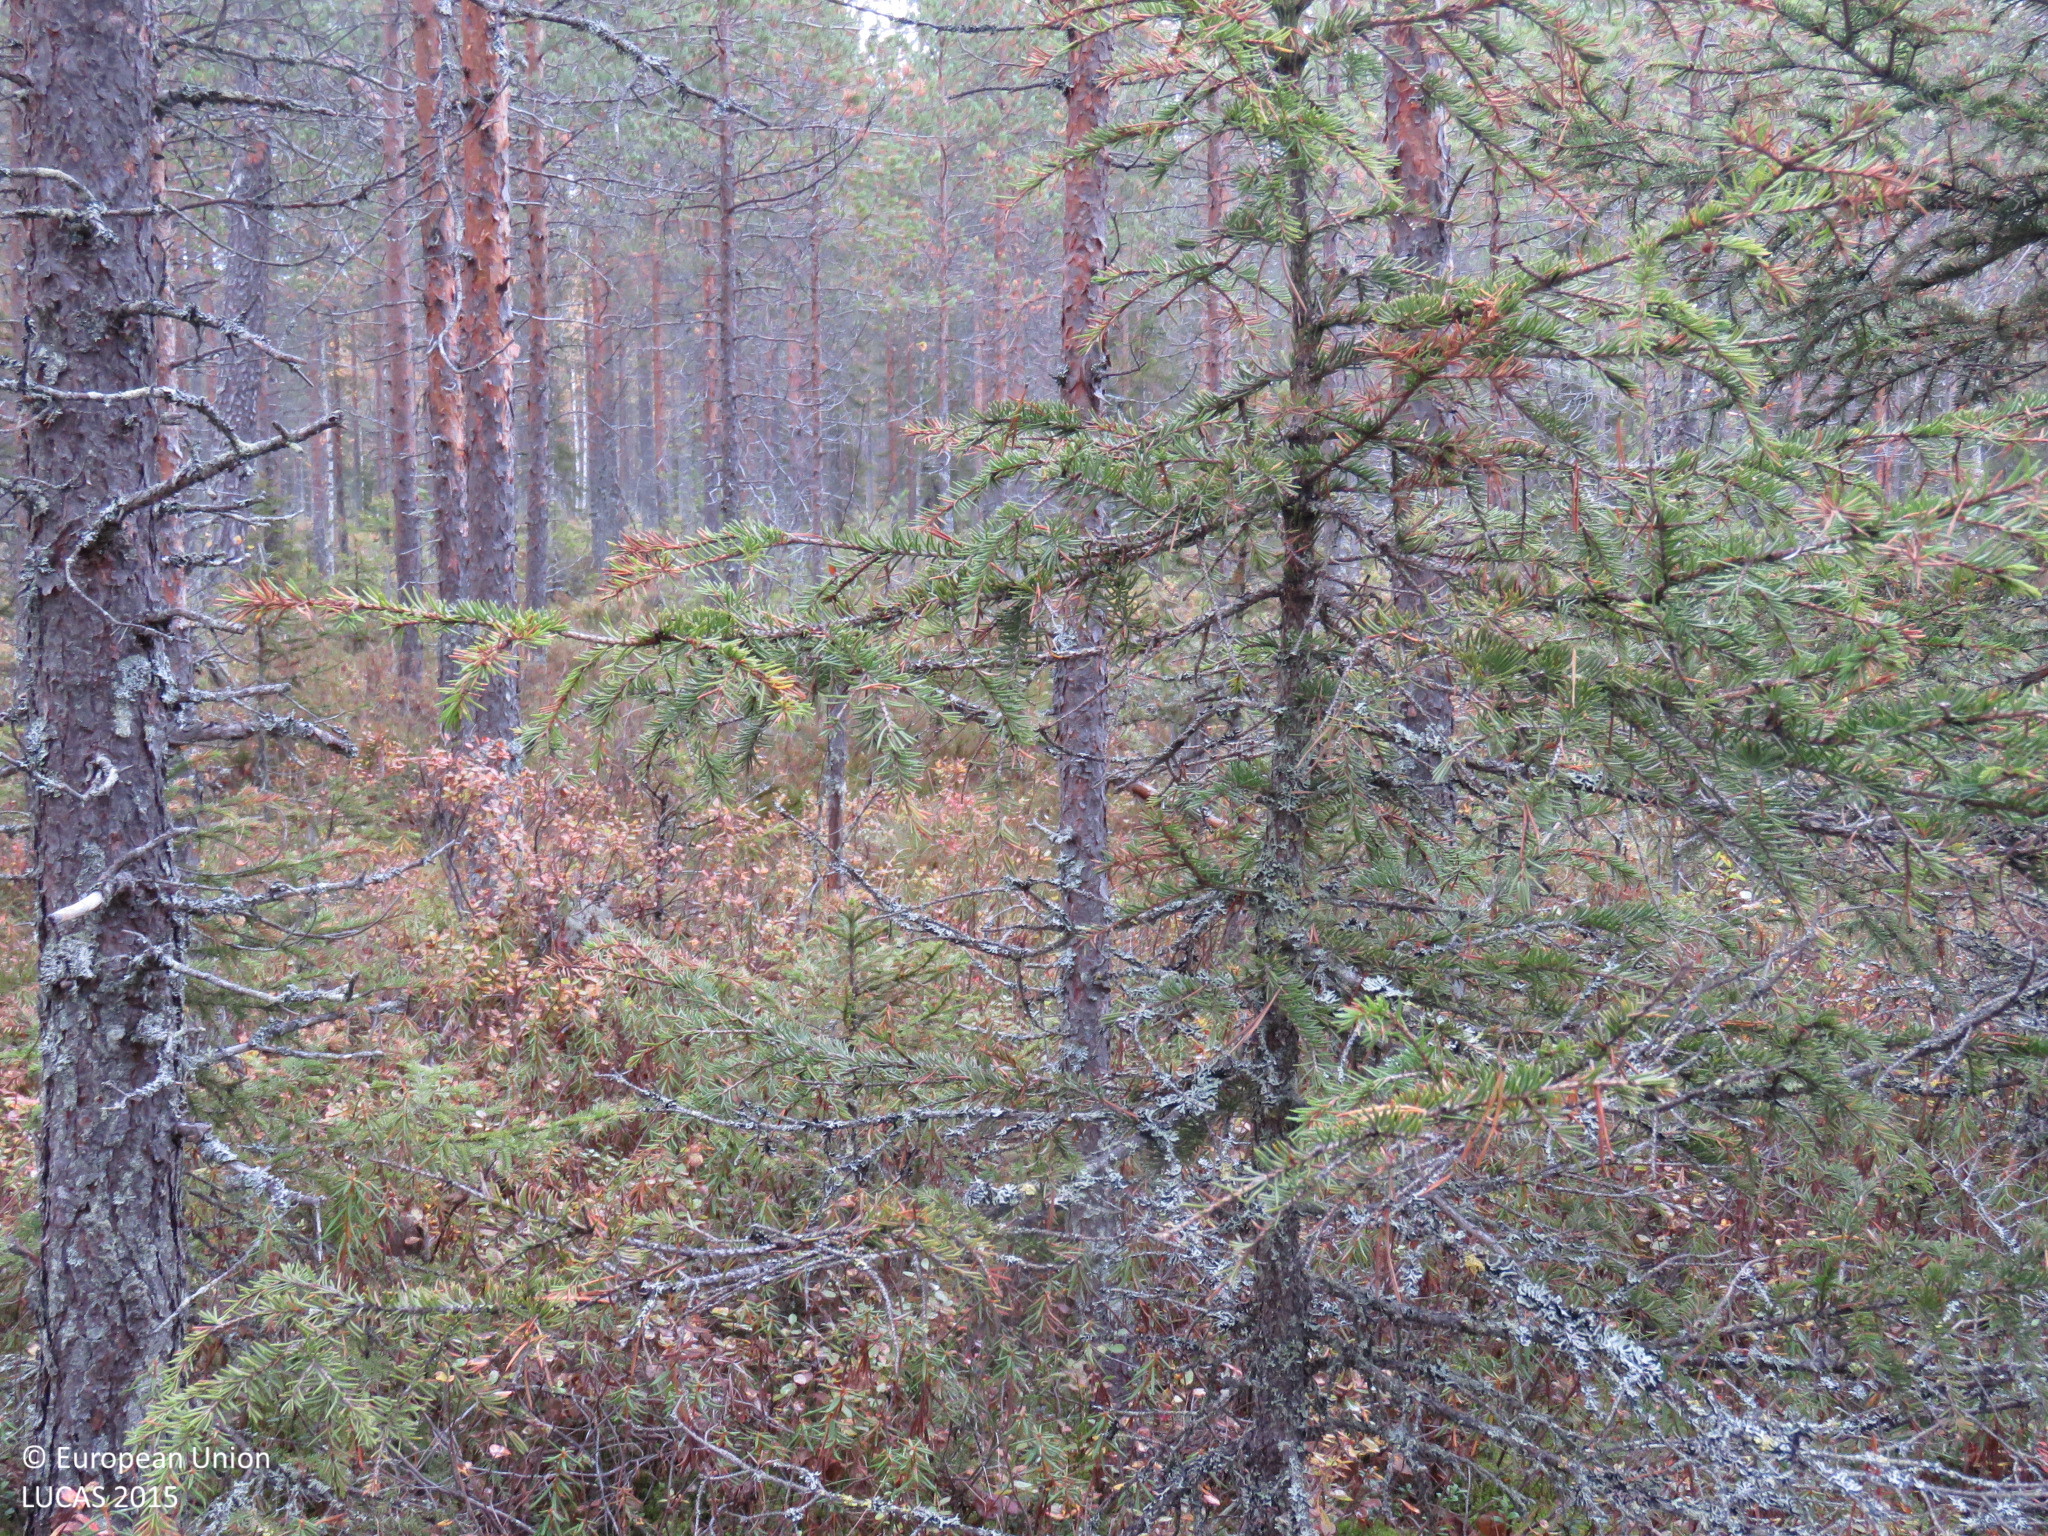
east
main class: Woodland
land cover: Other mixed woodland
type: mire and swamp forests
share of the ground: > 75 %
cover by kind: coniferous forest trees 50 %, broadleaved forest trees 25 %, shrubs 10 %, lichens and mosses 10 %, herbaceous plants 5 %
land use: Forestry
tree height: > 5 m
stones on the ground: < 10 %
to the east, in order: Other mixed woodland; Pine dominated coniferous woodland; Other mixed woodland; Pine dominated coniferous woodland
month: September
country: FI
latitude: 64.8395
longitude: 27.0529
